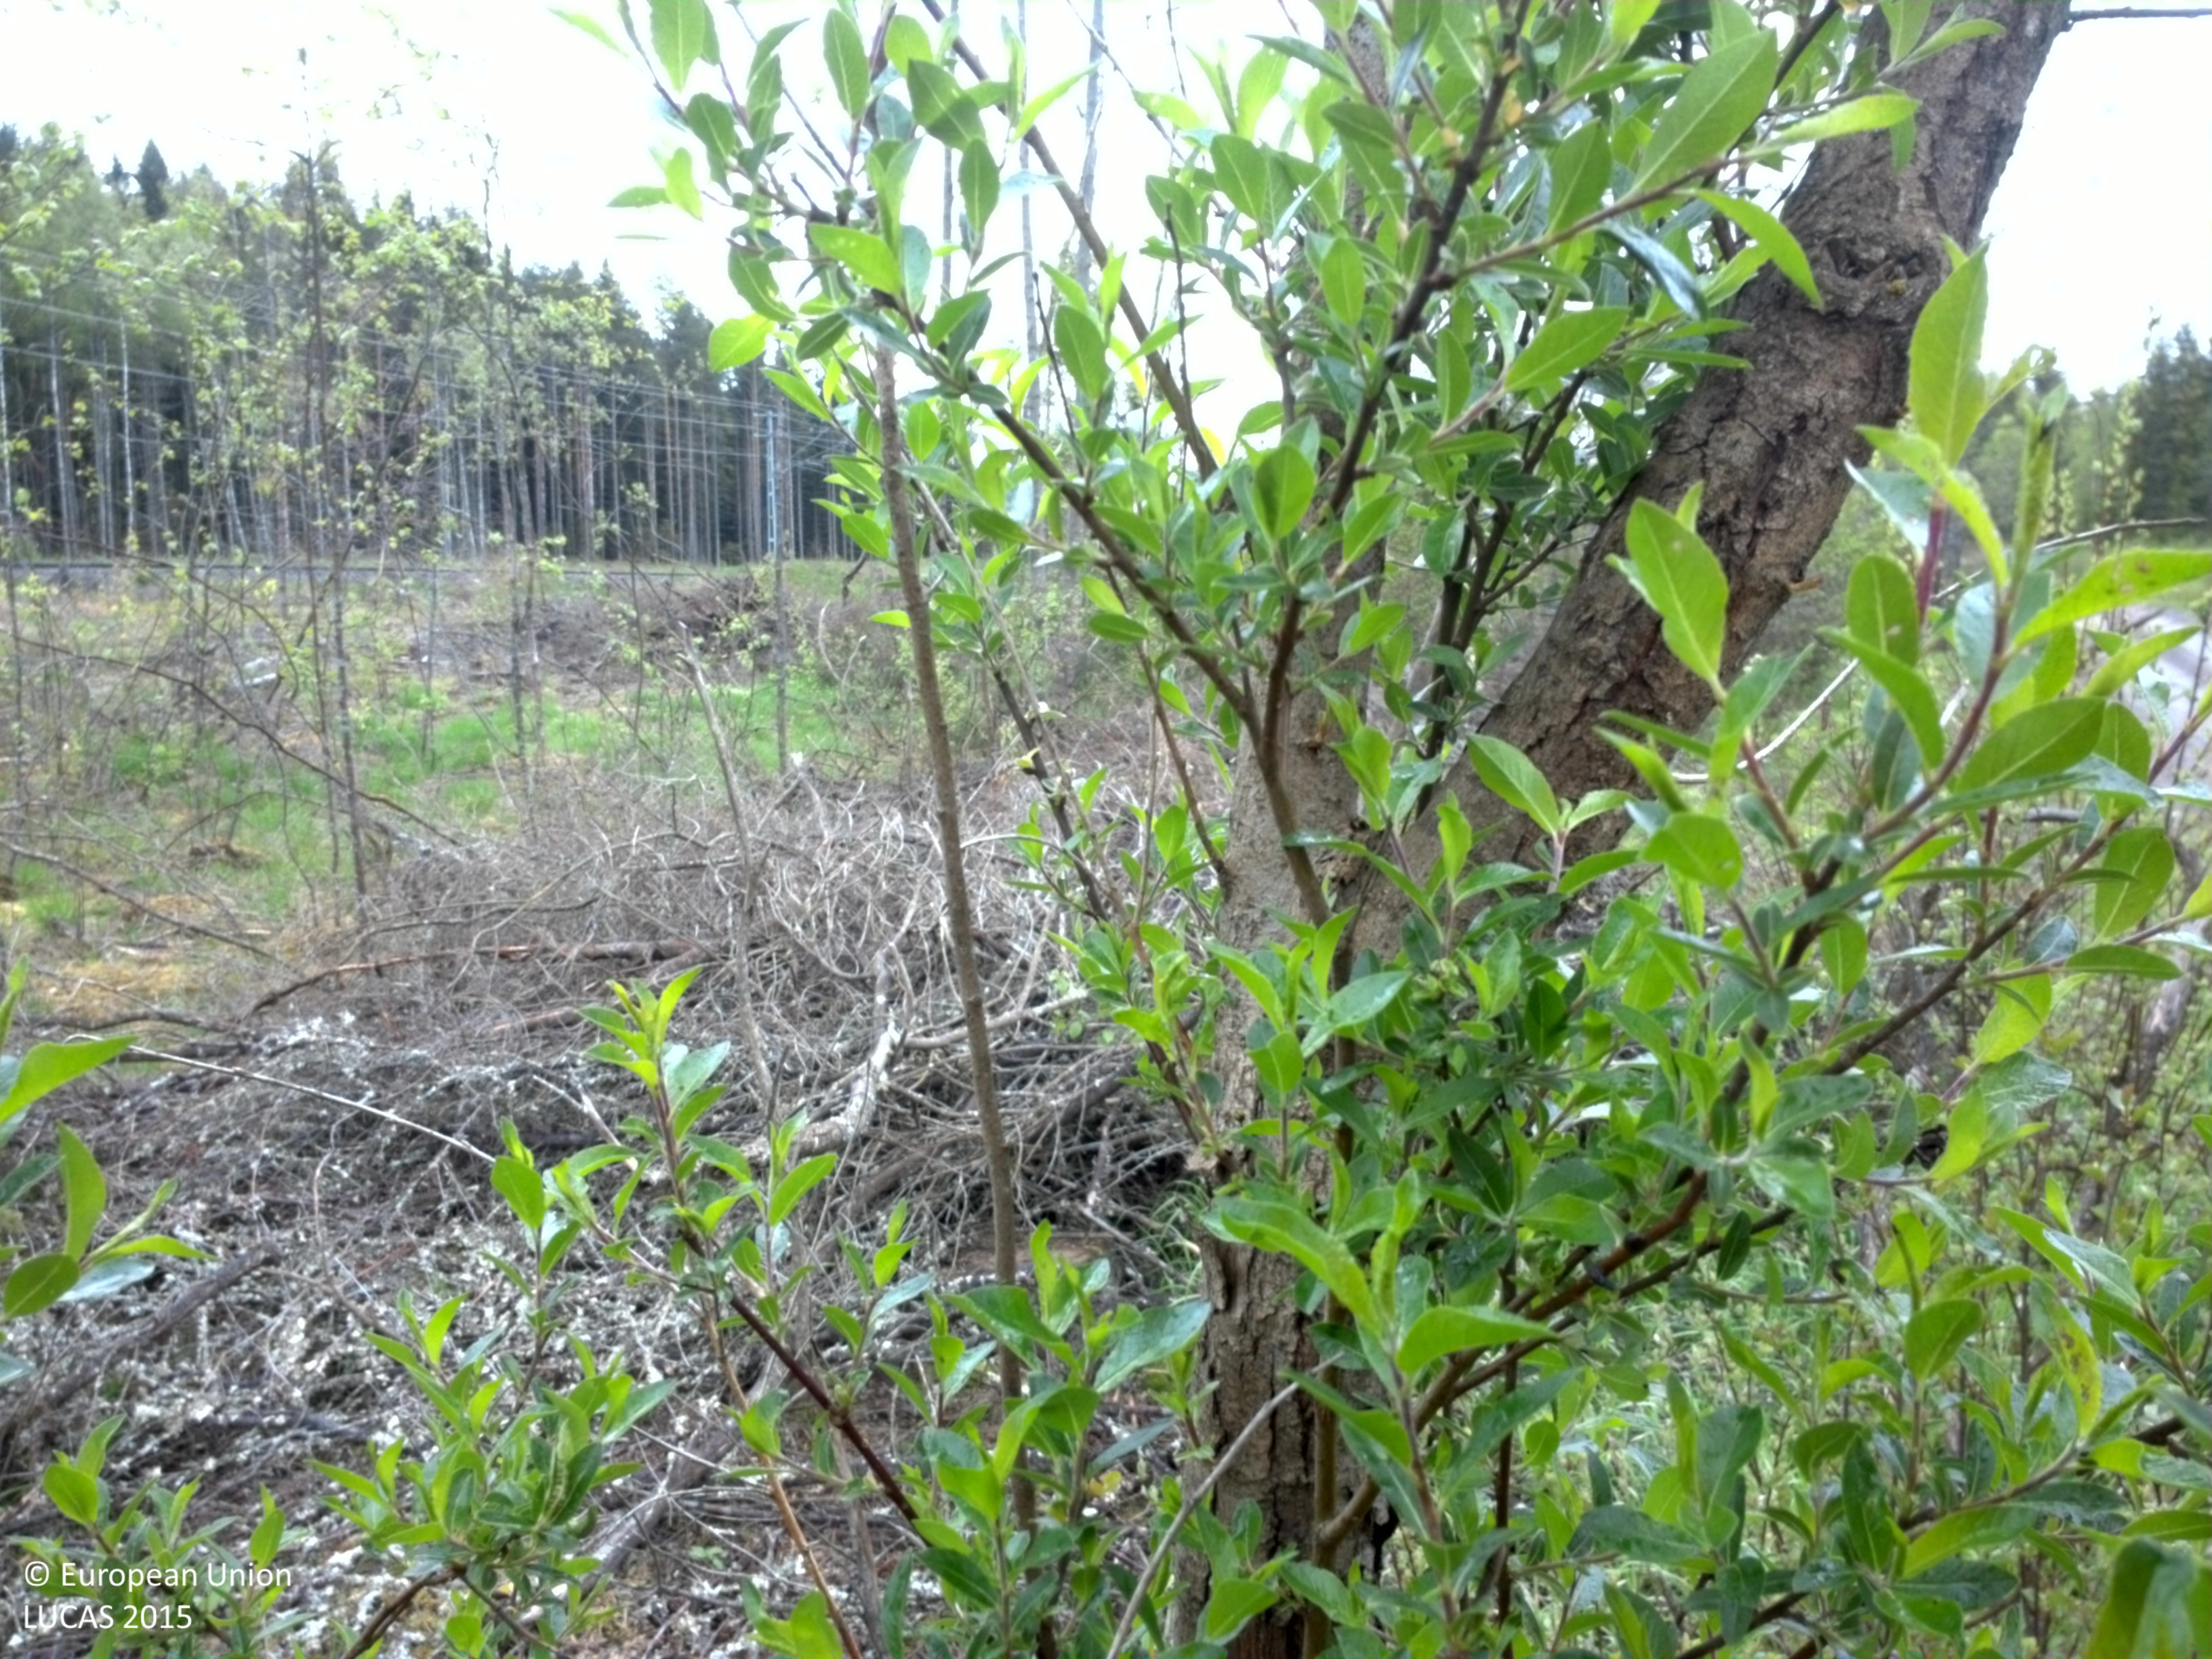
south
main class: Woodland
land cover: Broadleaved woodland
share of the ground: 25 - 50 %
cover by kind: herbaceous plants 40 %, broadleaved forest trees 35 %, lichens and mosses 15 %, coniferous forest trees 5 %, shrubs 5 %
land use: Forestry
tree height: > 5 m
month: May
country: SE
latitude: 59.3623
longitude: 14.1610
